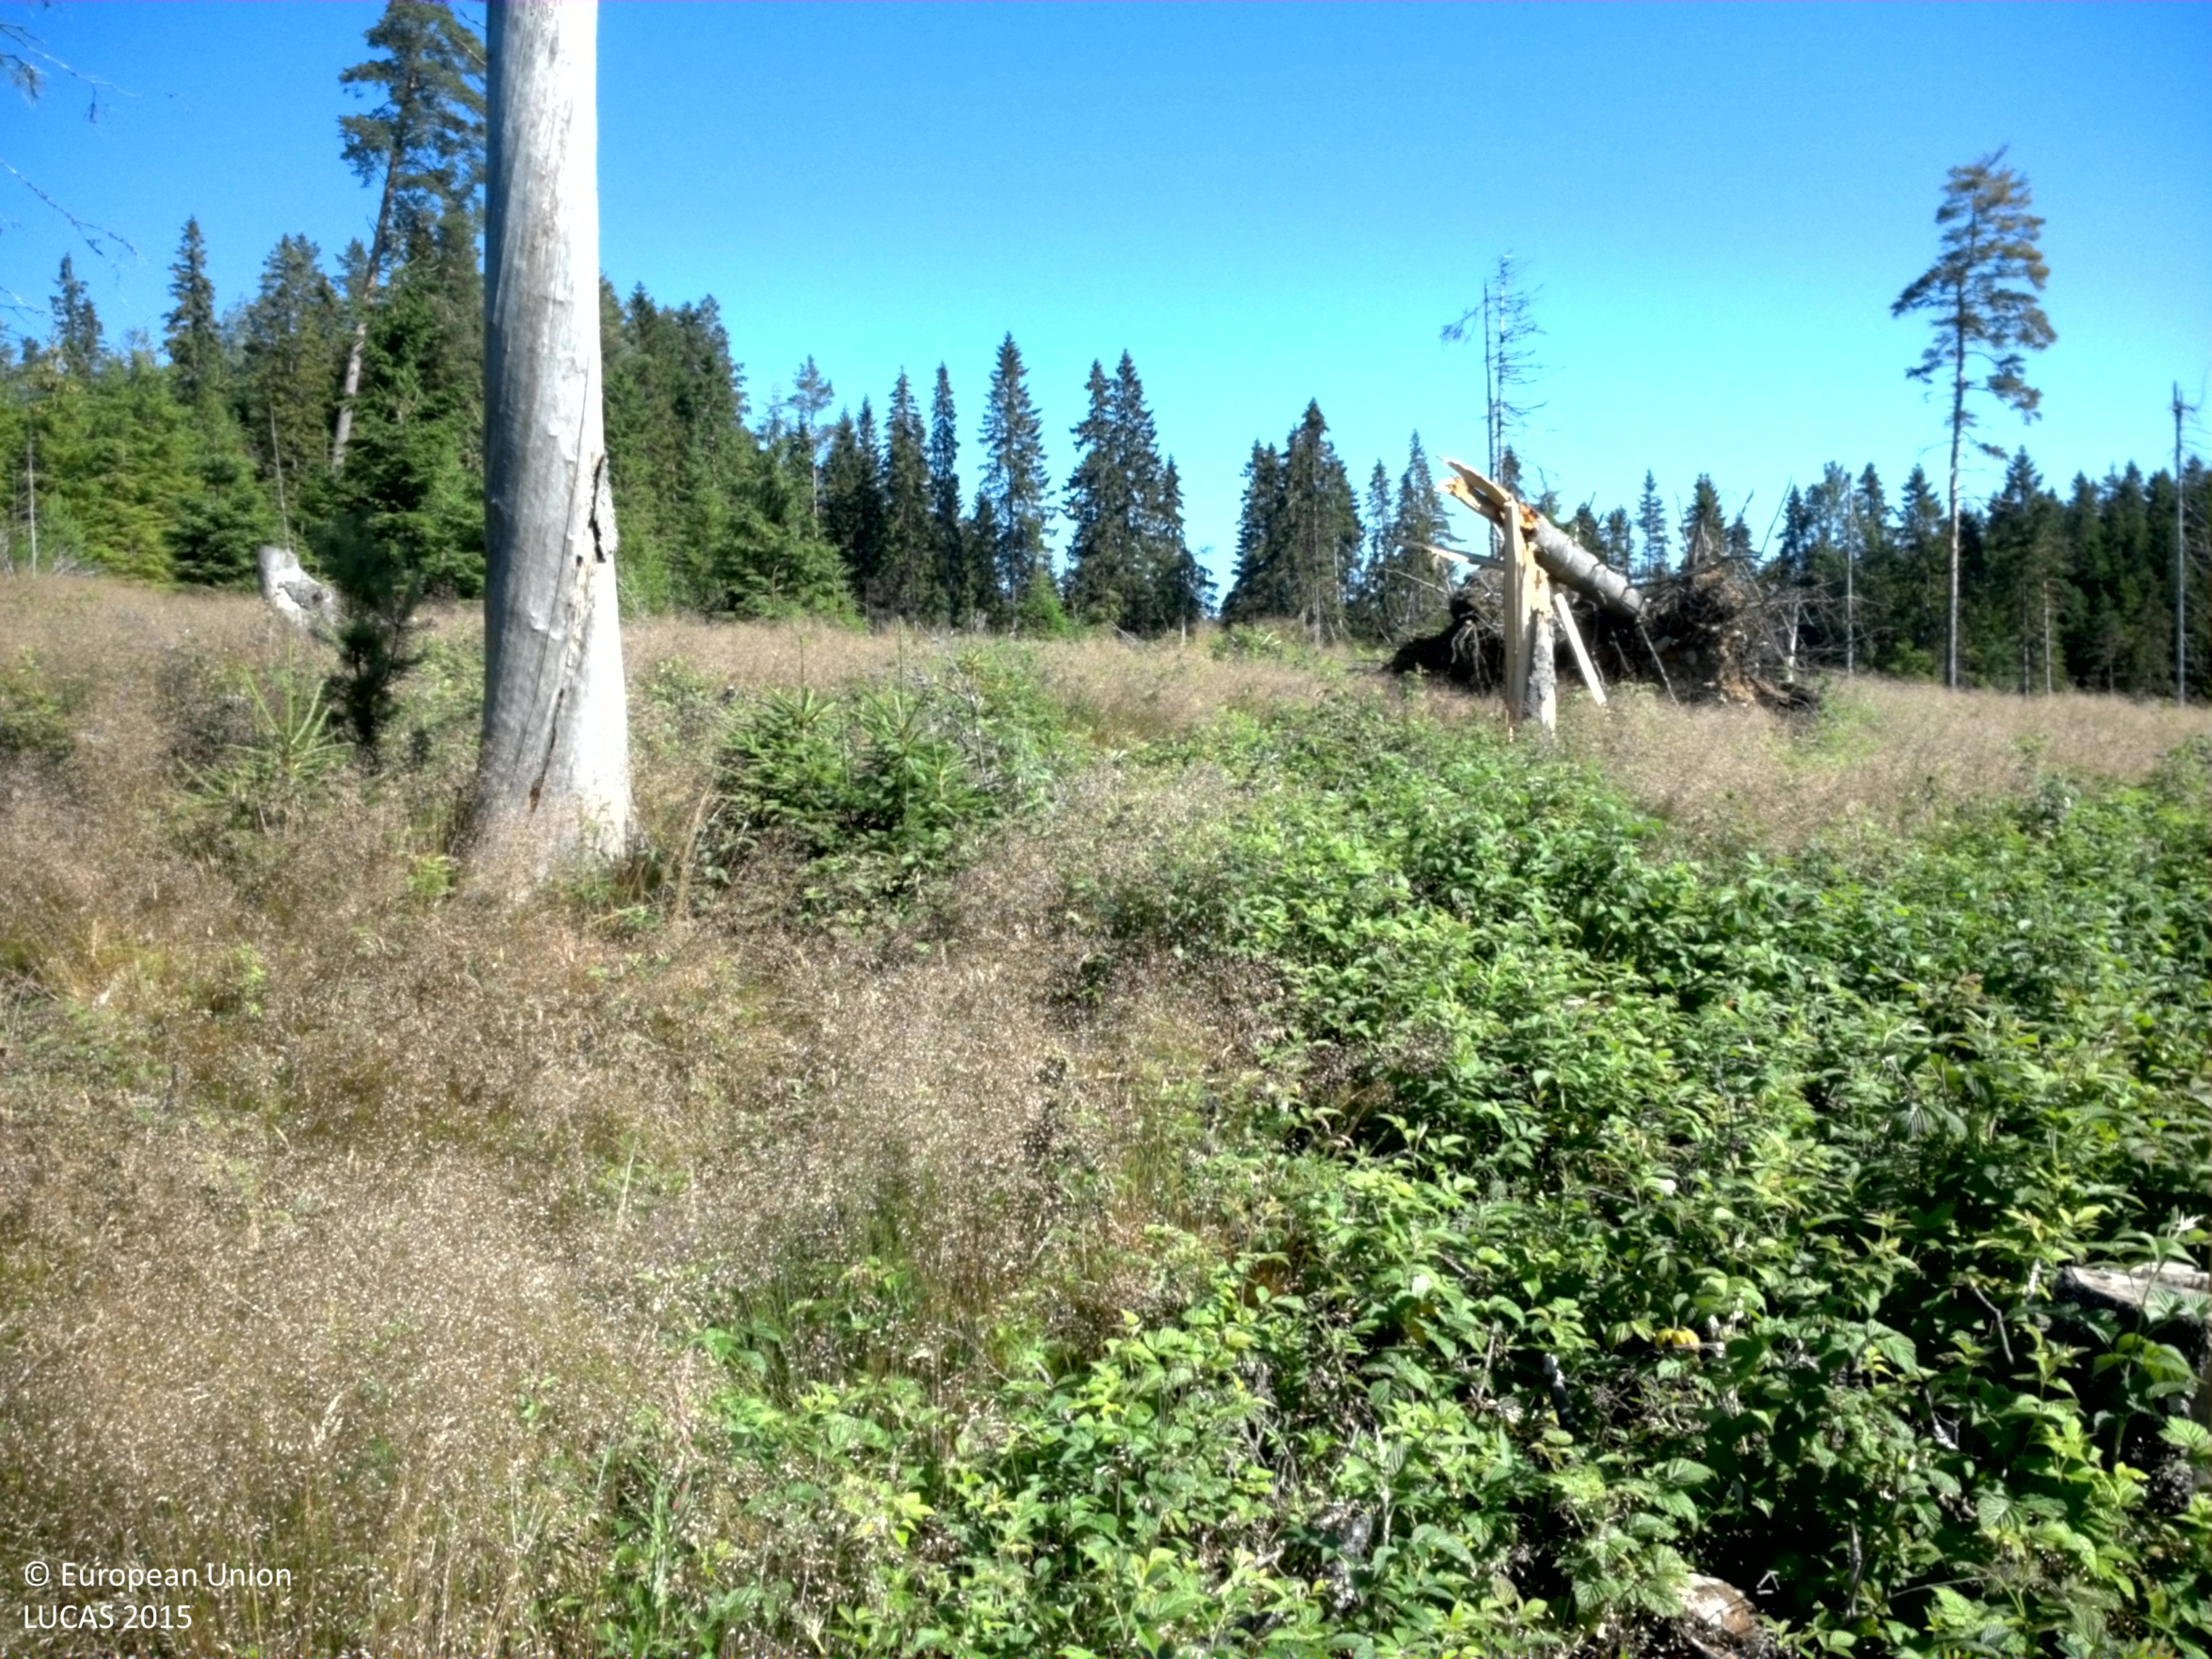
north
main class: Woodland
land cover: Spruce dominated coniferous woodland
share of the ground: 10 - 25 %
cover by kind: shrubs 45 %, herbaceous plants 40 %, coniferous forest trees 15 %
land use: Forestry
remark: Clear cut
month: July
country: SE
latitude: 59.7149
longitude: 14.4170
